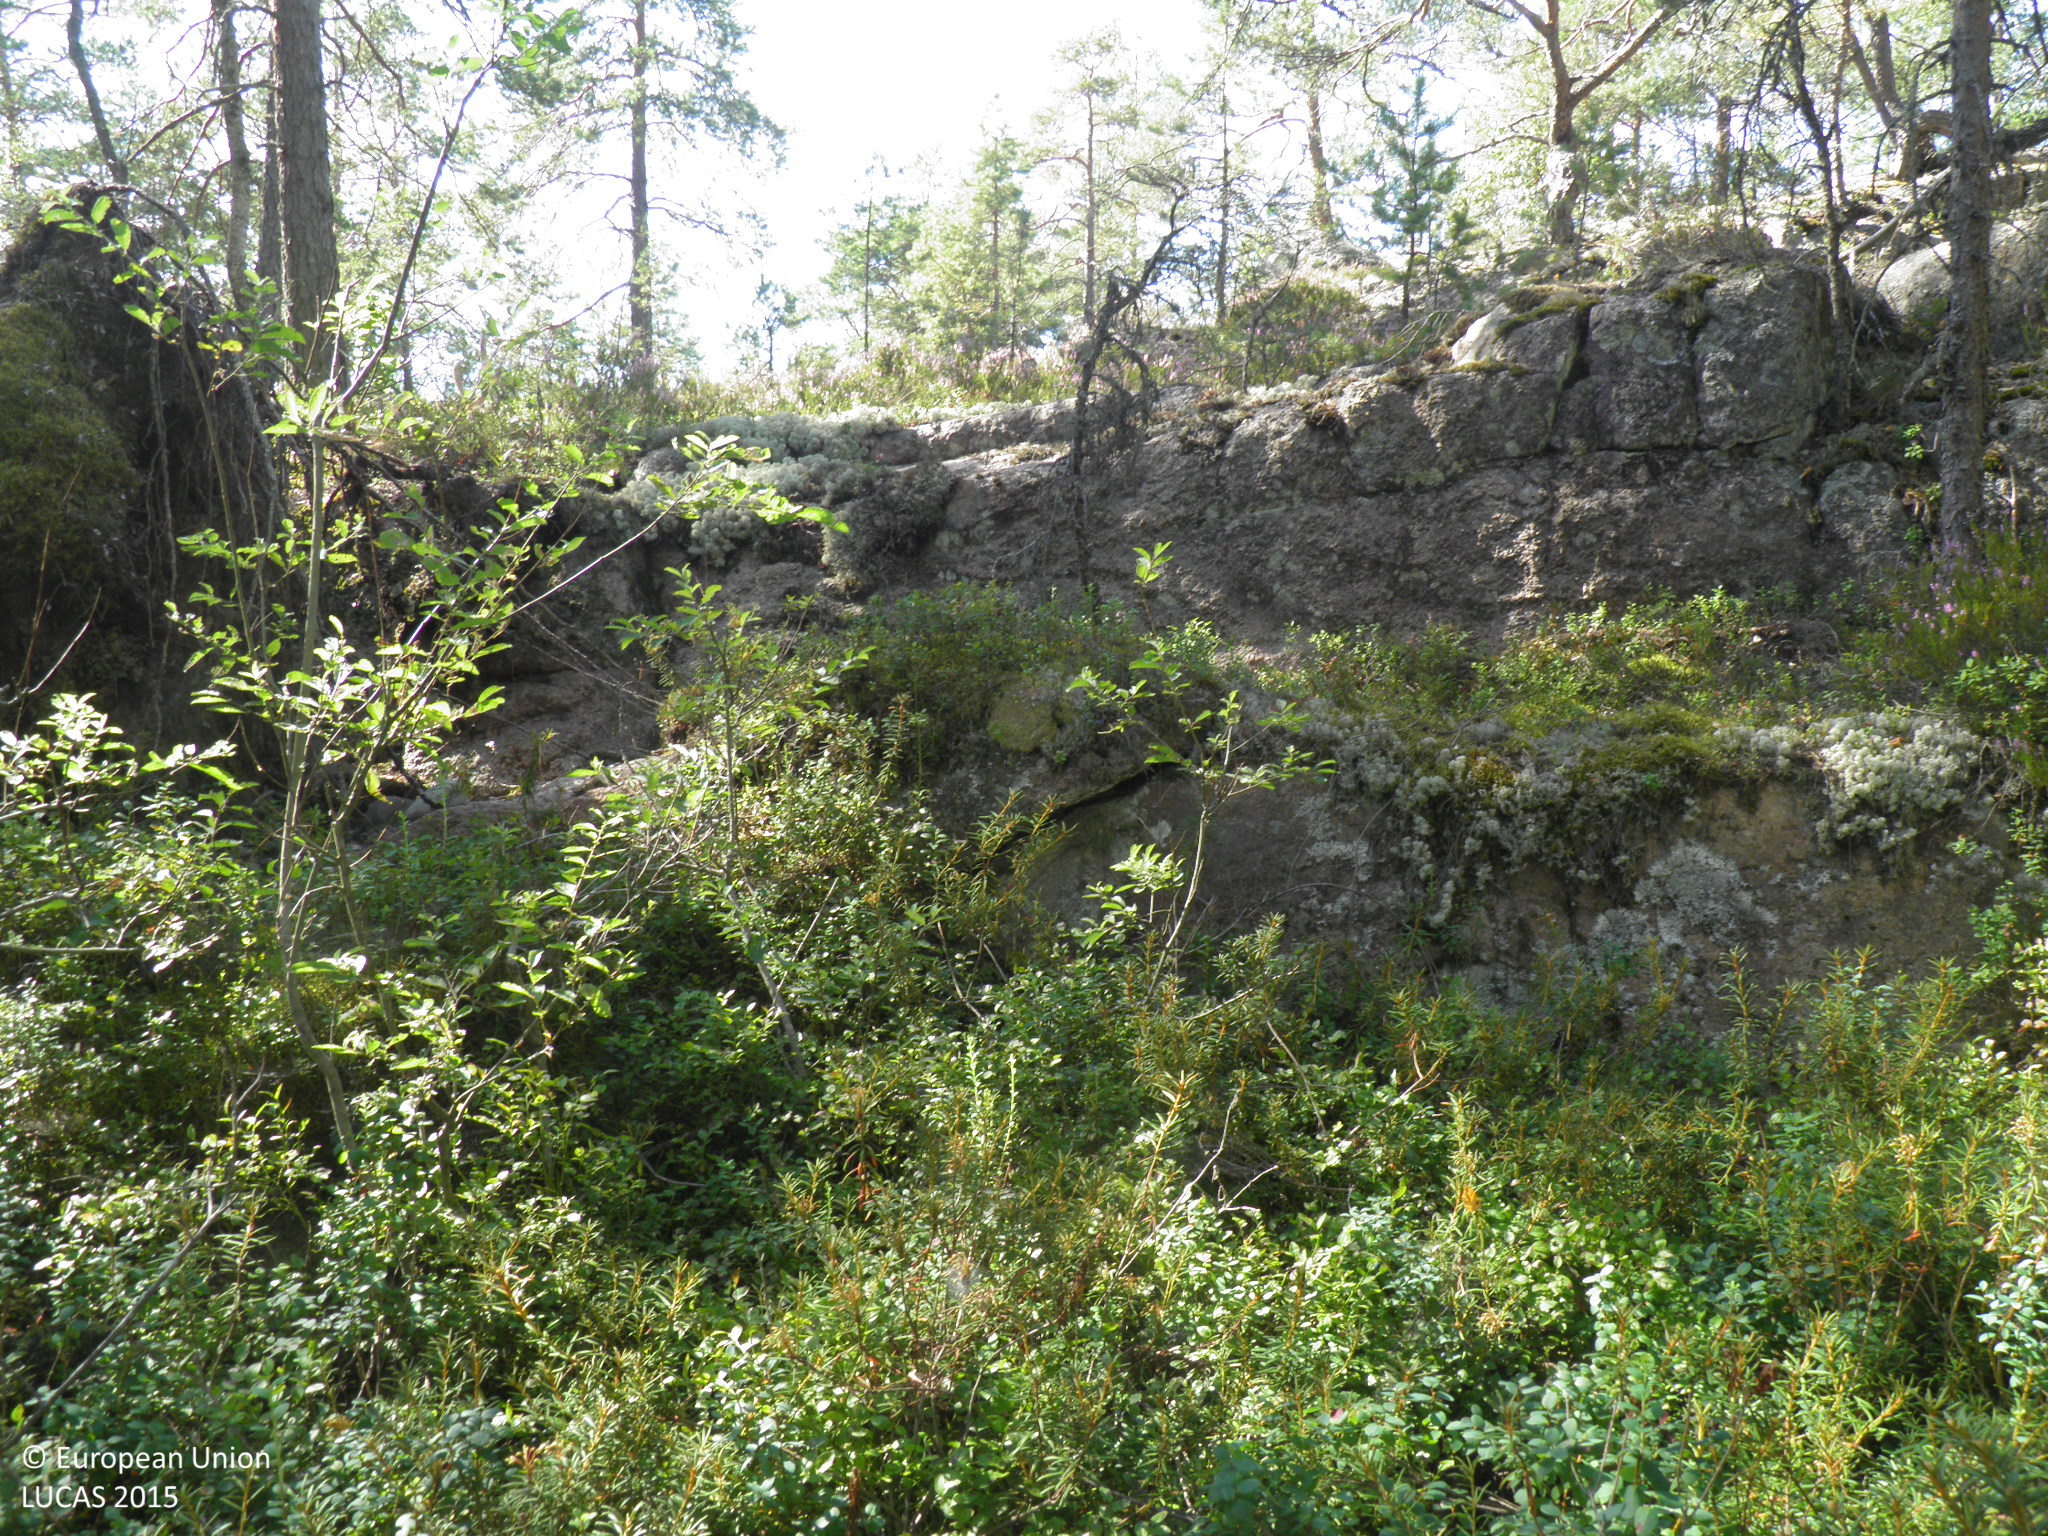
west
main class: Woodland
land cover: Pine dominated coniferous woodland
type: hemiboreal forest and nemoral coniferous forest and mixed broadleaved-coniferous forest
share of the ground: 50 - 75 %
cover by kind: coniferous forest trees 50 %, shrubs 30 %, lichens and mosses 10 %, consolidated bare surface 10 %
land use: Semi-natural and natural areas not in use
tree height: > 5 m
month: August
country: FI
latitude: 60.2077
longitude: 22.6873
